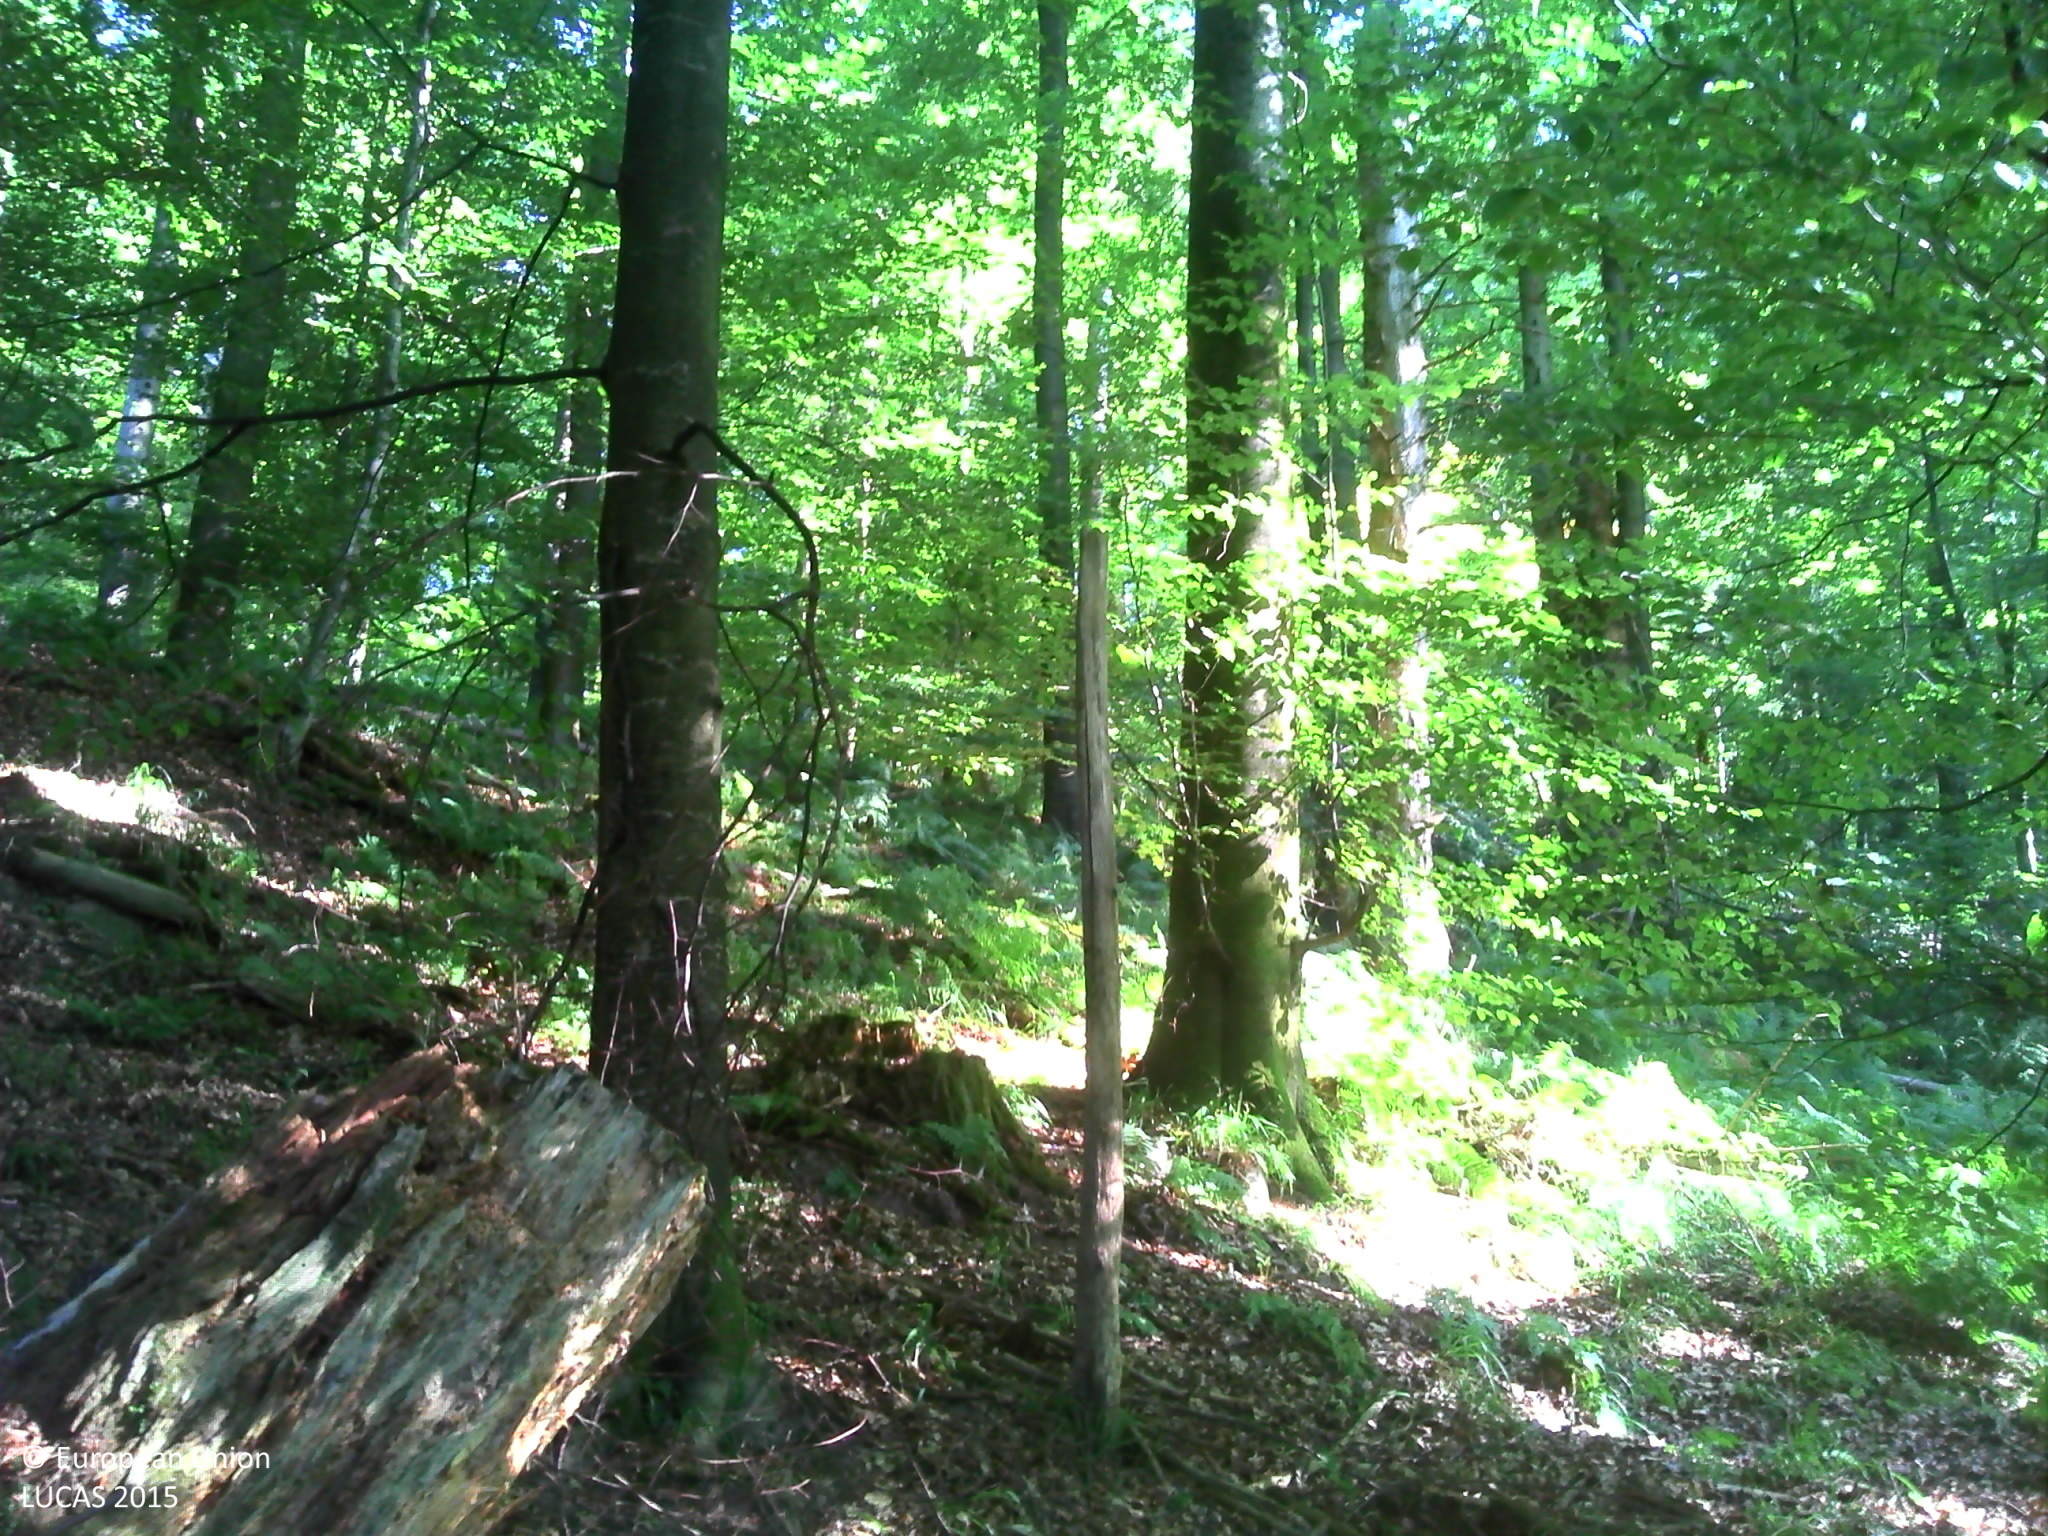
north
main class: Woodland
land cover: Broadleaved woodland
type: beech forest
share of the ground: > 75 %
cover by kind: broadleaved forest trees 95 %, coniferous forest trees 5 %
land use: Forestry
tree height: > 5 m
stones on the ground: < 10 %
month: July
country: FR
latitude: 48.7851
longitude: 7.3194
